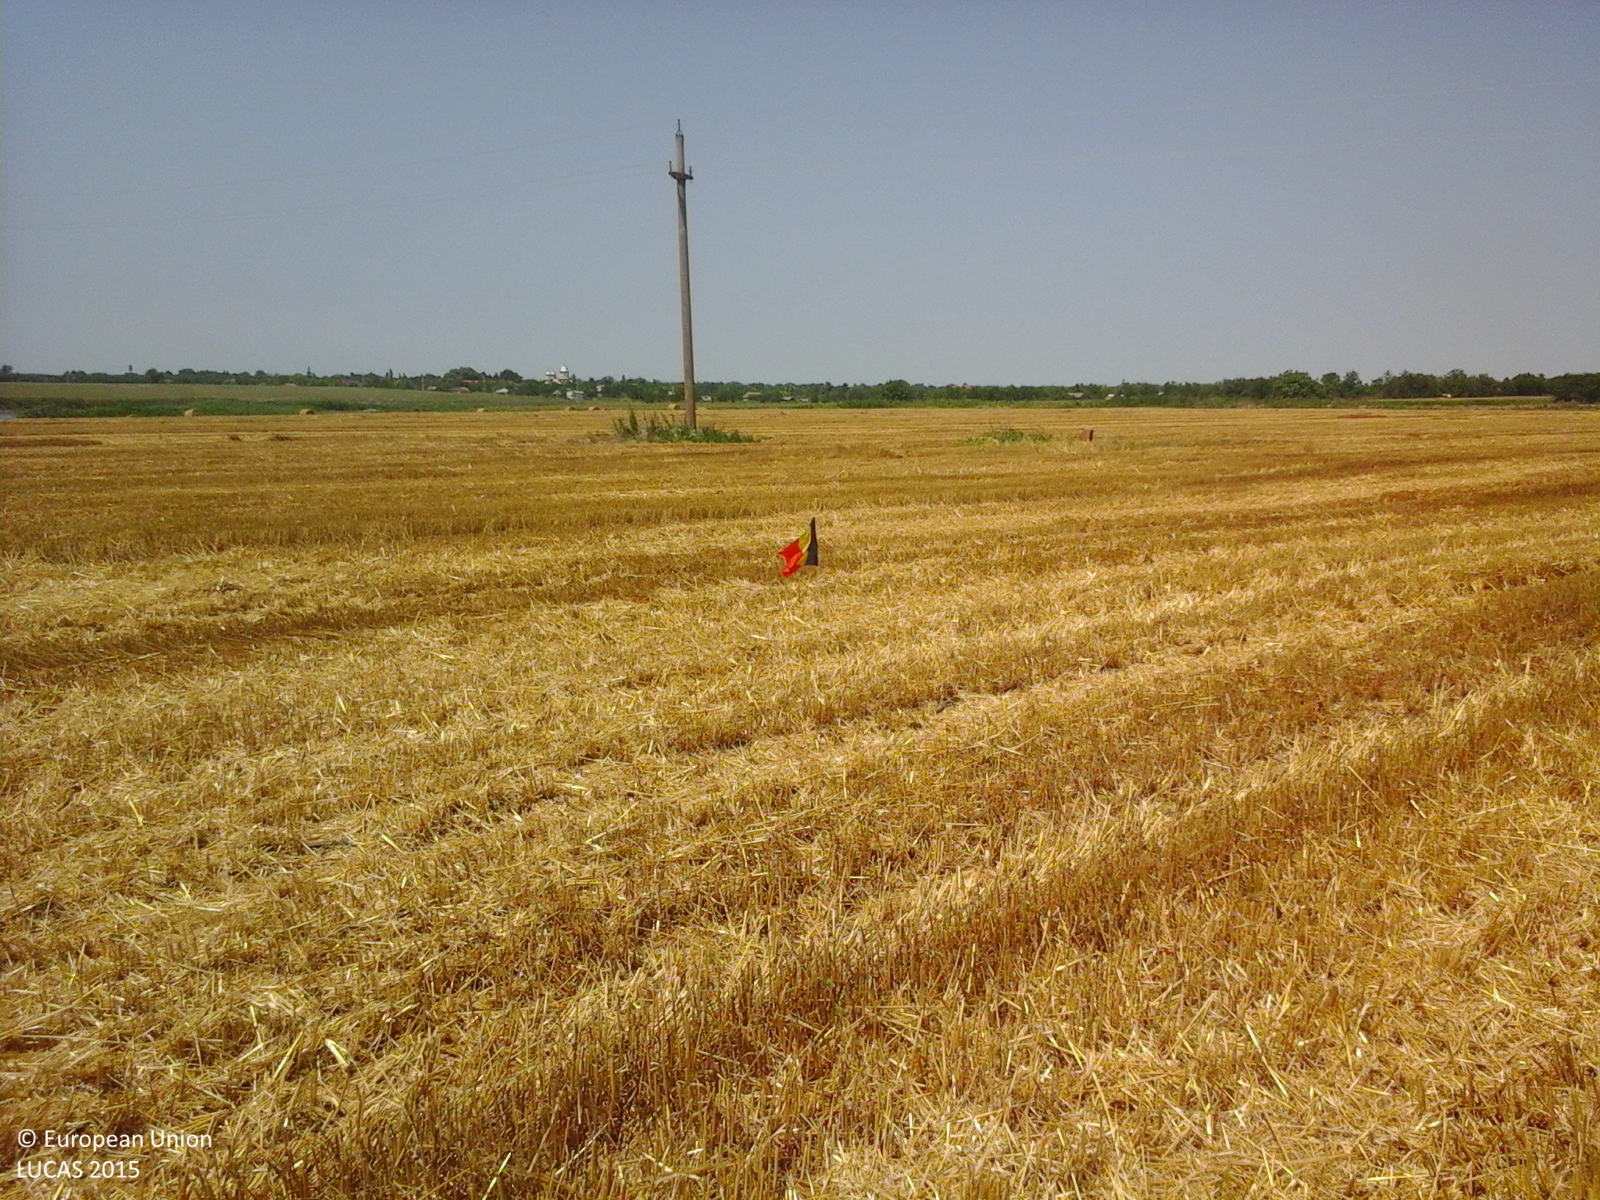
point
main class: Cropland
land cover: Common wheat
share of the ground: > 75 %
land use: Agriculture (excluding fallow land and kitchen gardens)
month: July
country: RO
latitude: 44.7019
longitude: 27.1088
